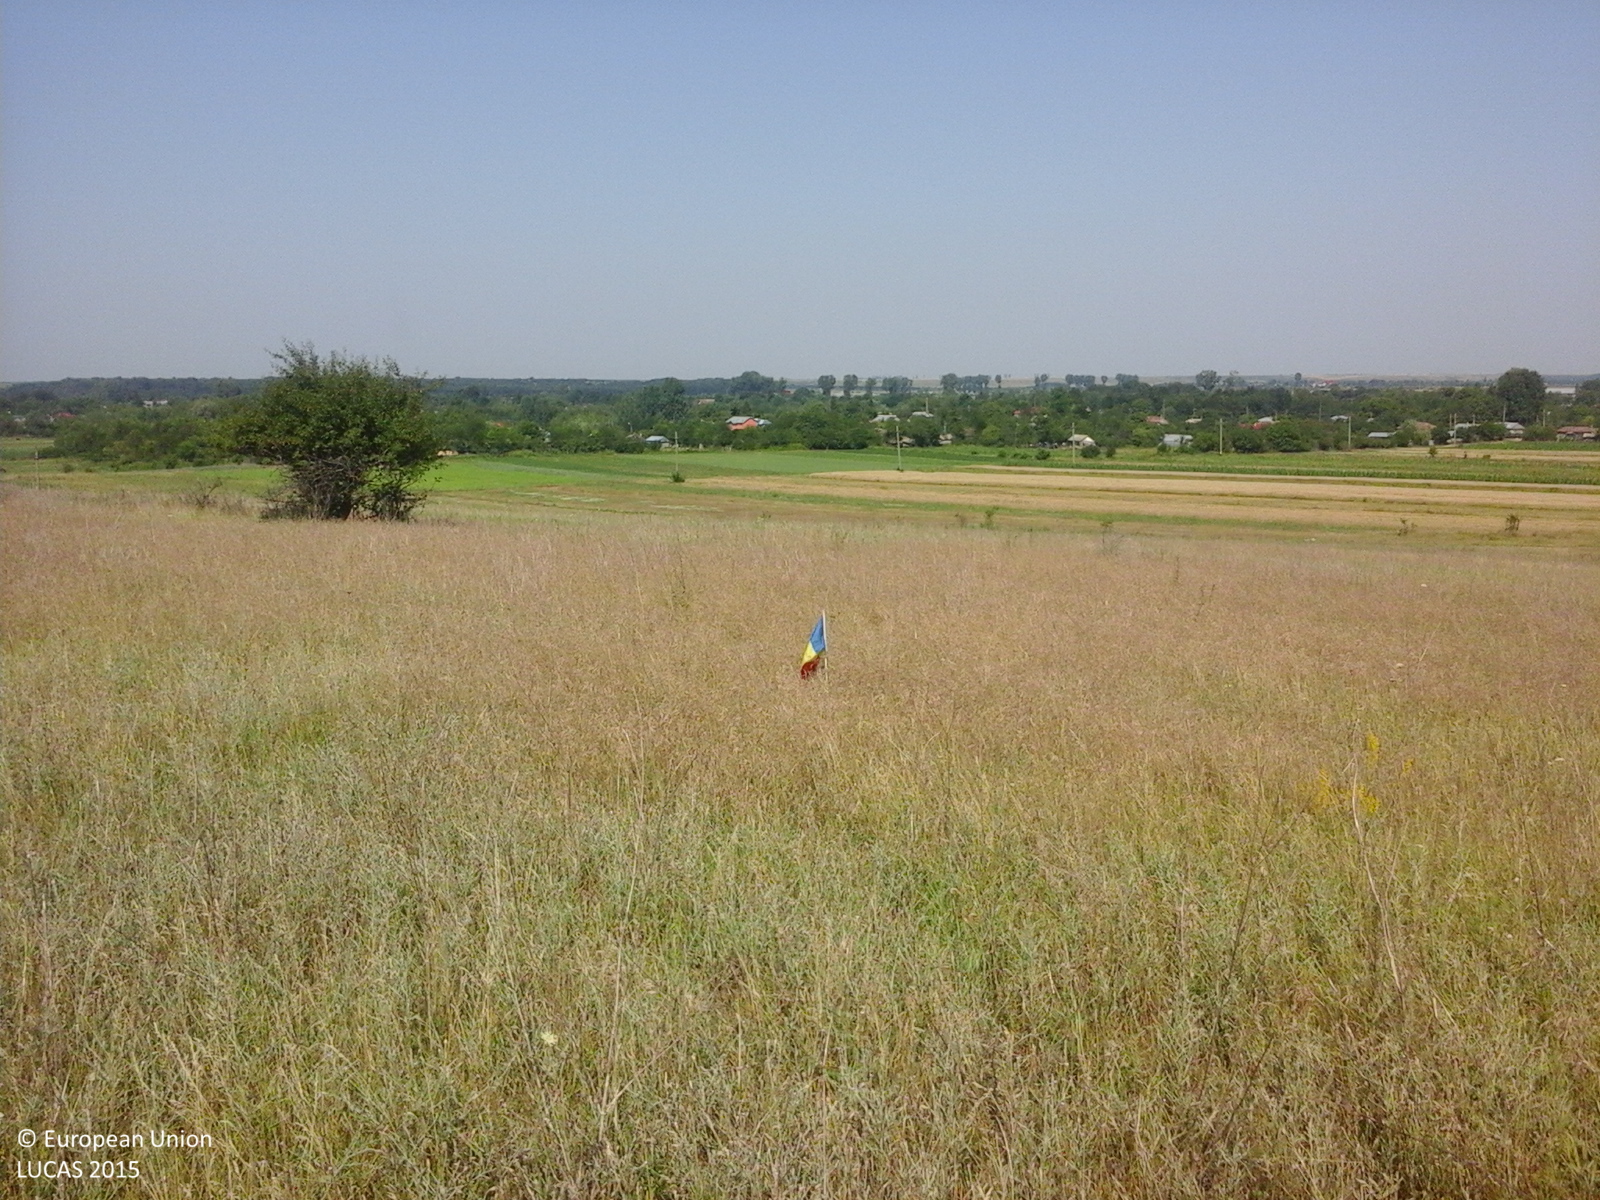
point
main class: Grassland
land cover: Grassland without tree/shrub cover
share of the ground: > 75 %
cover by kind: herbaceous plants 100 %
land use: Agriculture (excluding fallow land and kitchen gardens)
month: July
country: RO
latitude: 44.1784
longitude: 25.3072
